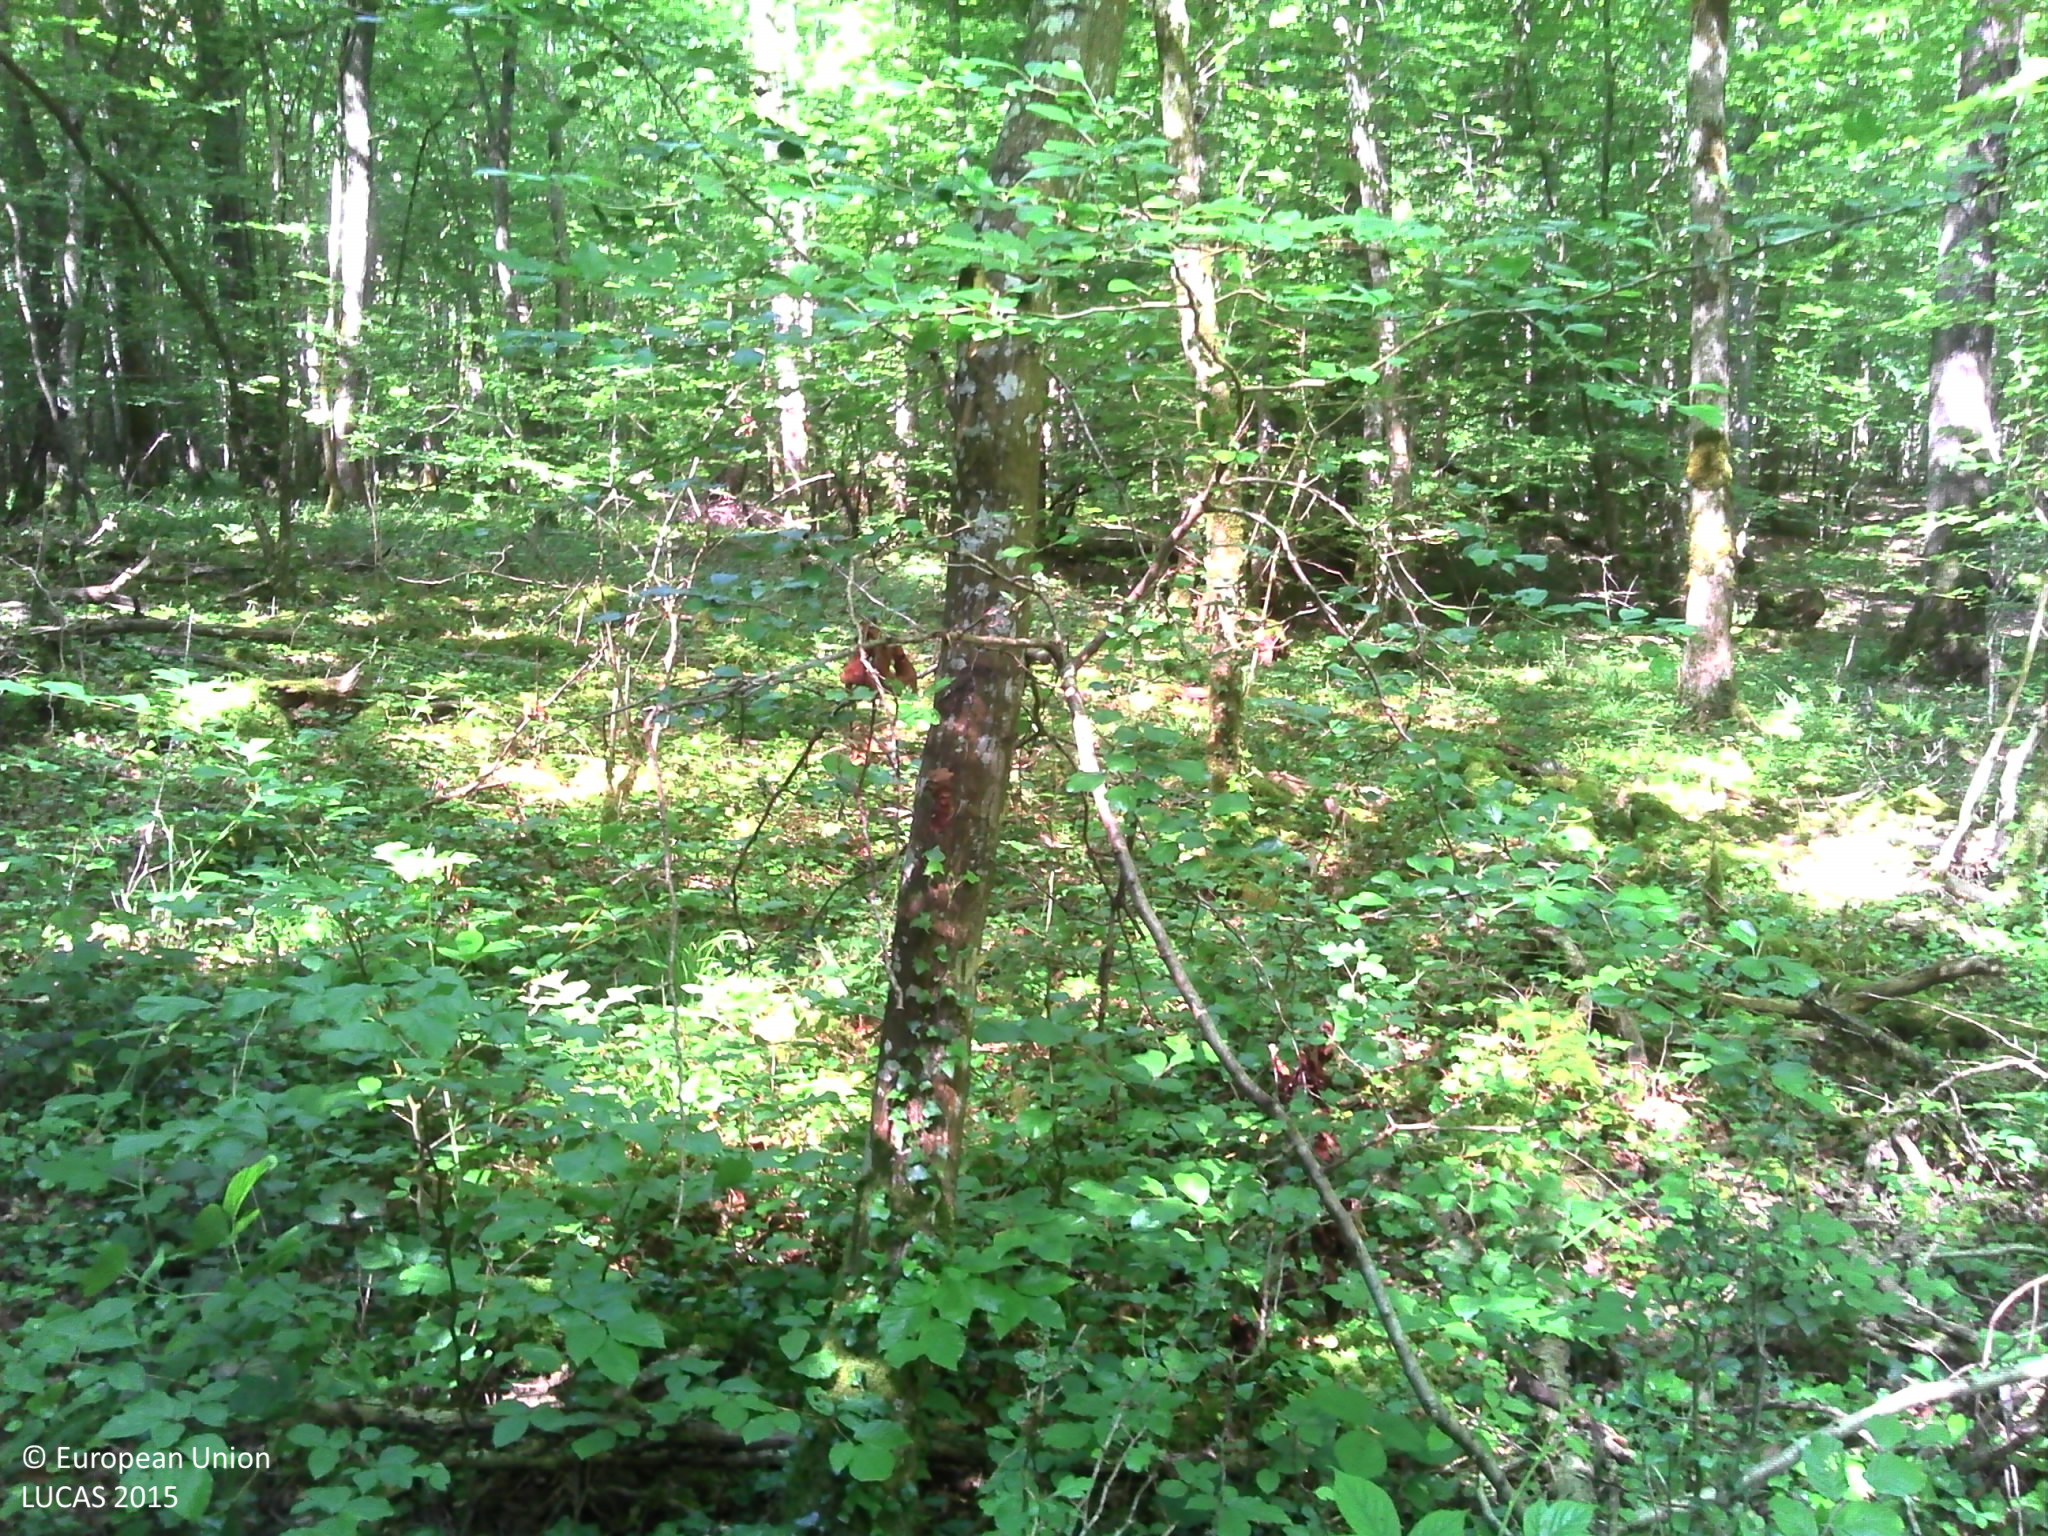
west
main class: Woodland
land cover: Broadleaved woodland
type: acidophilous oak and oak-birch forest
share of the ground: > 75 %
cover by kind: broadleaved forest trees 90 %, herbaceous plants 5 %, lichens and mosses 5 %
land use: Forestry
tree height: > 5 m
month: June
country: FR
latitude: 47.6239
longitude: 3.9429
